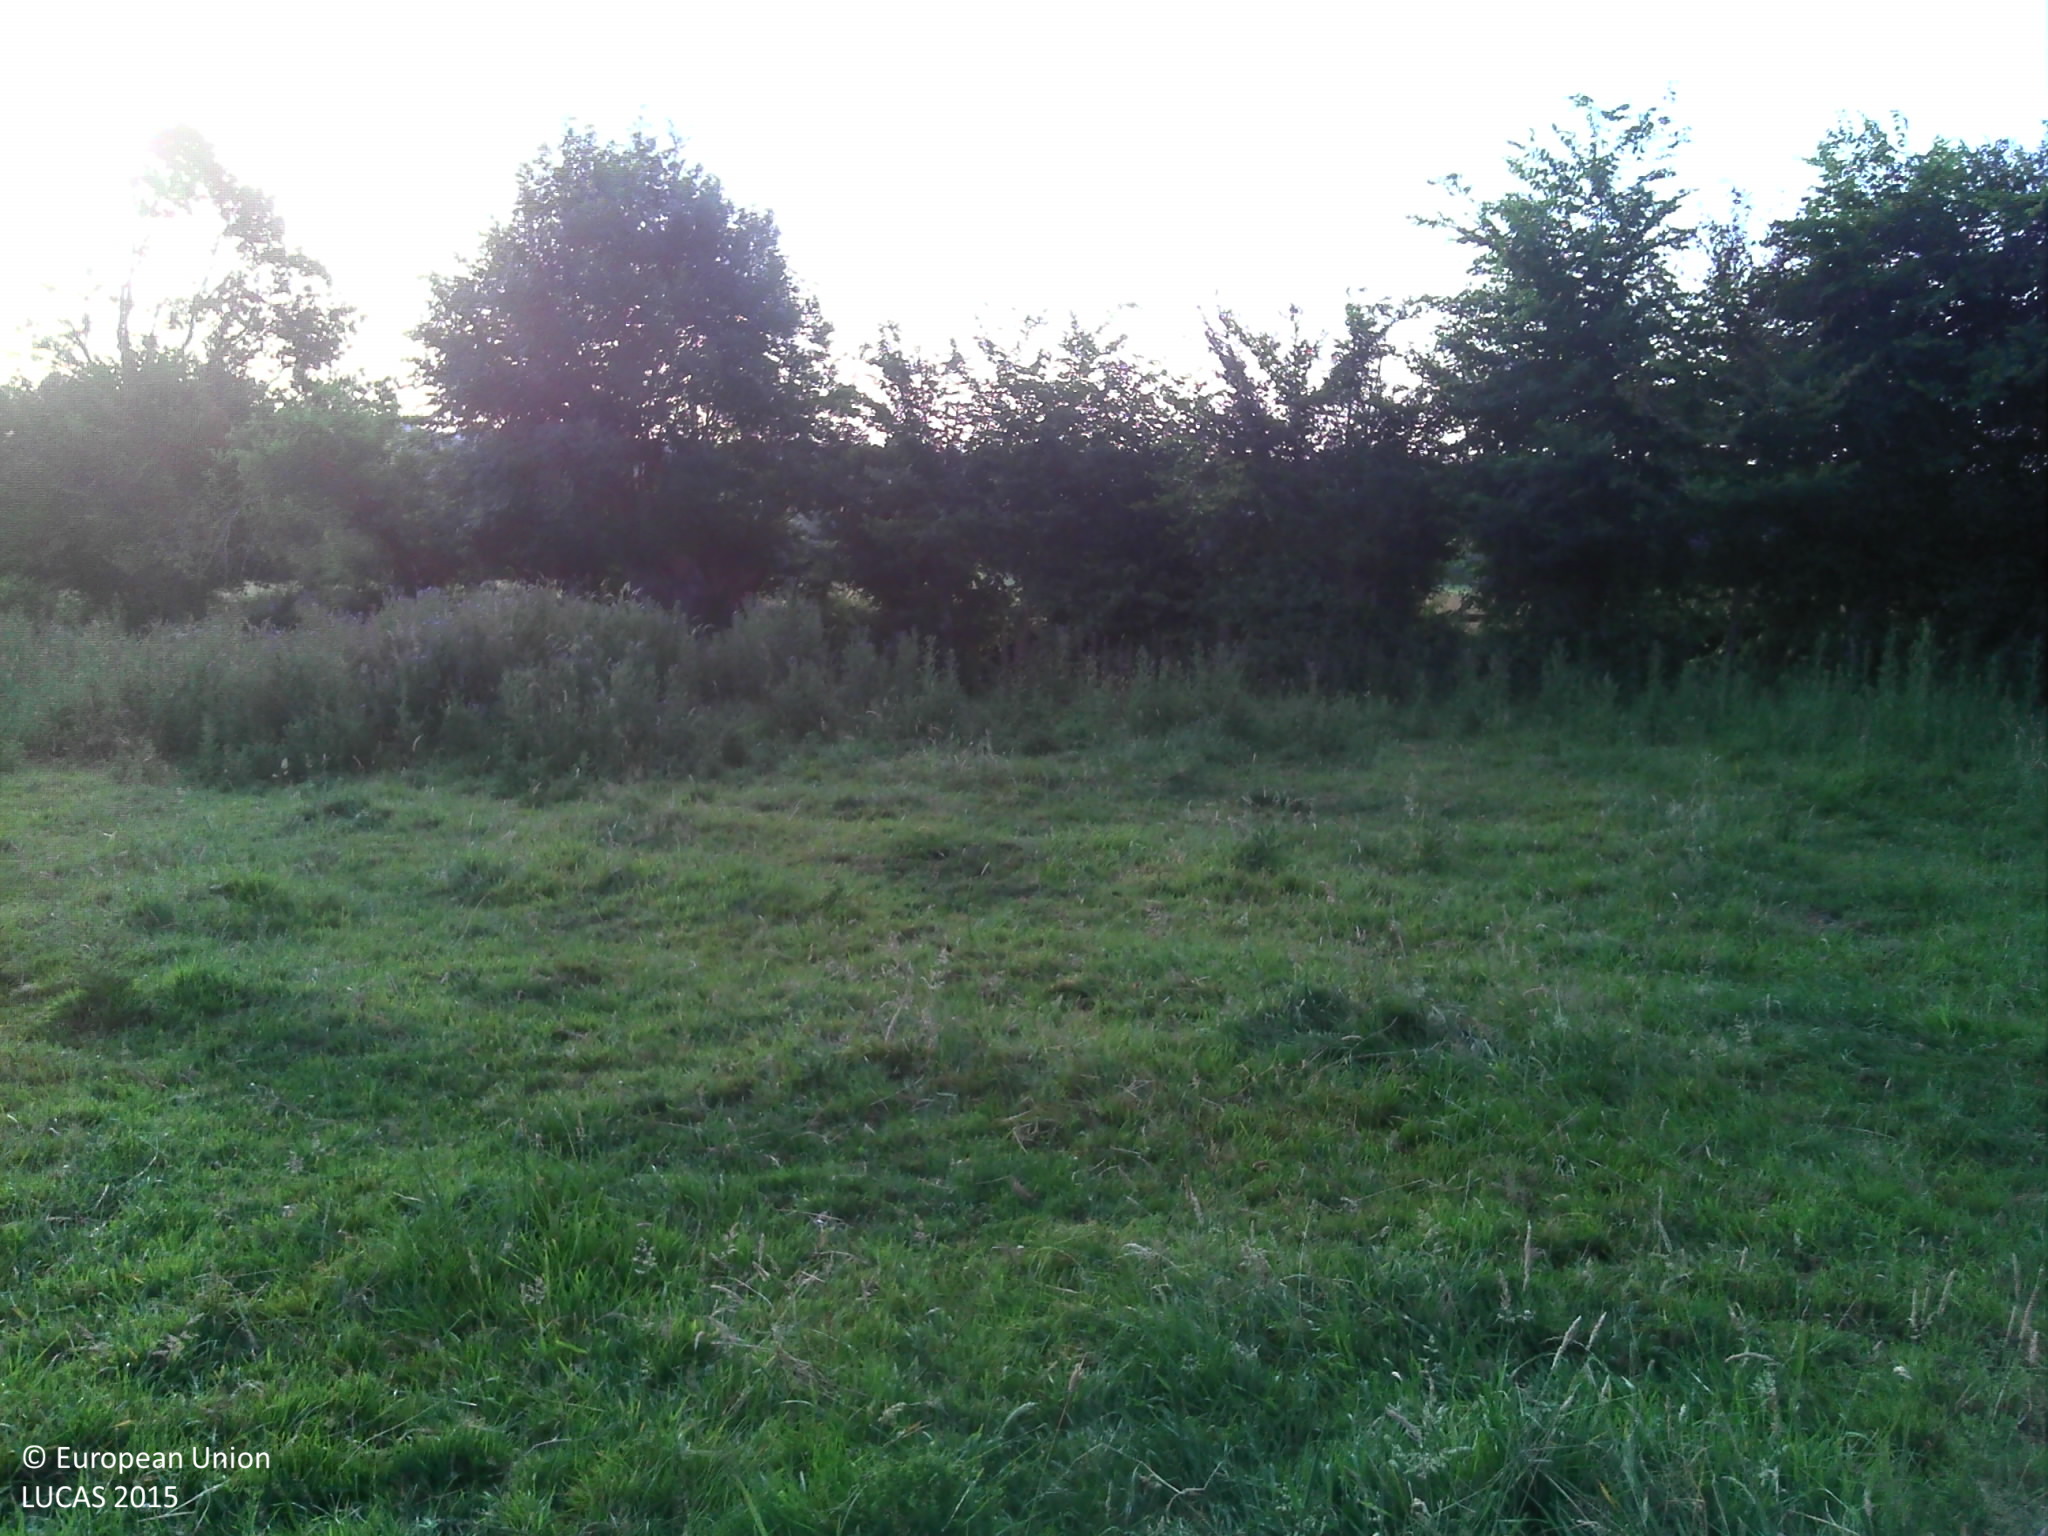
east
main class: Grassland
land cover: Grassland without tree/shrub cover
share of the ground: > 75 %
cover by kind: herbaceous plants 100 %
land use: Agriculture (excluding fallow land and kitchen gardens)
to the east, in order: Grassland without tree/shrub cover; Fences; Managed hedges; Tracks; Fences; Grassland without tree/shrub cover; Fences; Ditches and canals
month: July
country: FR
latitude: 49.0308
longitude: 0.1366
